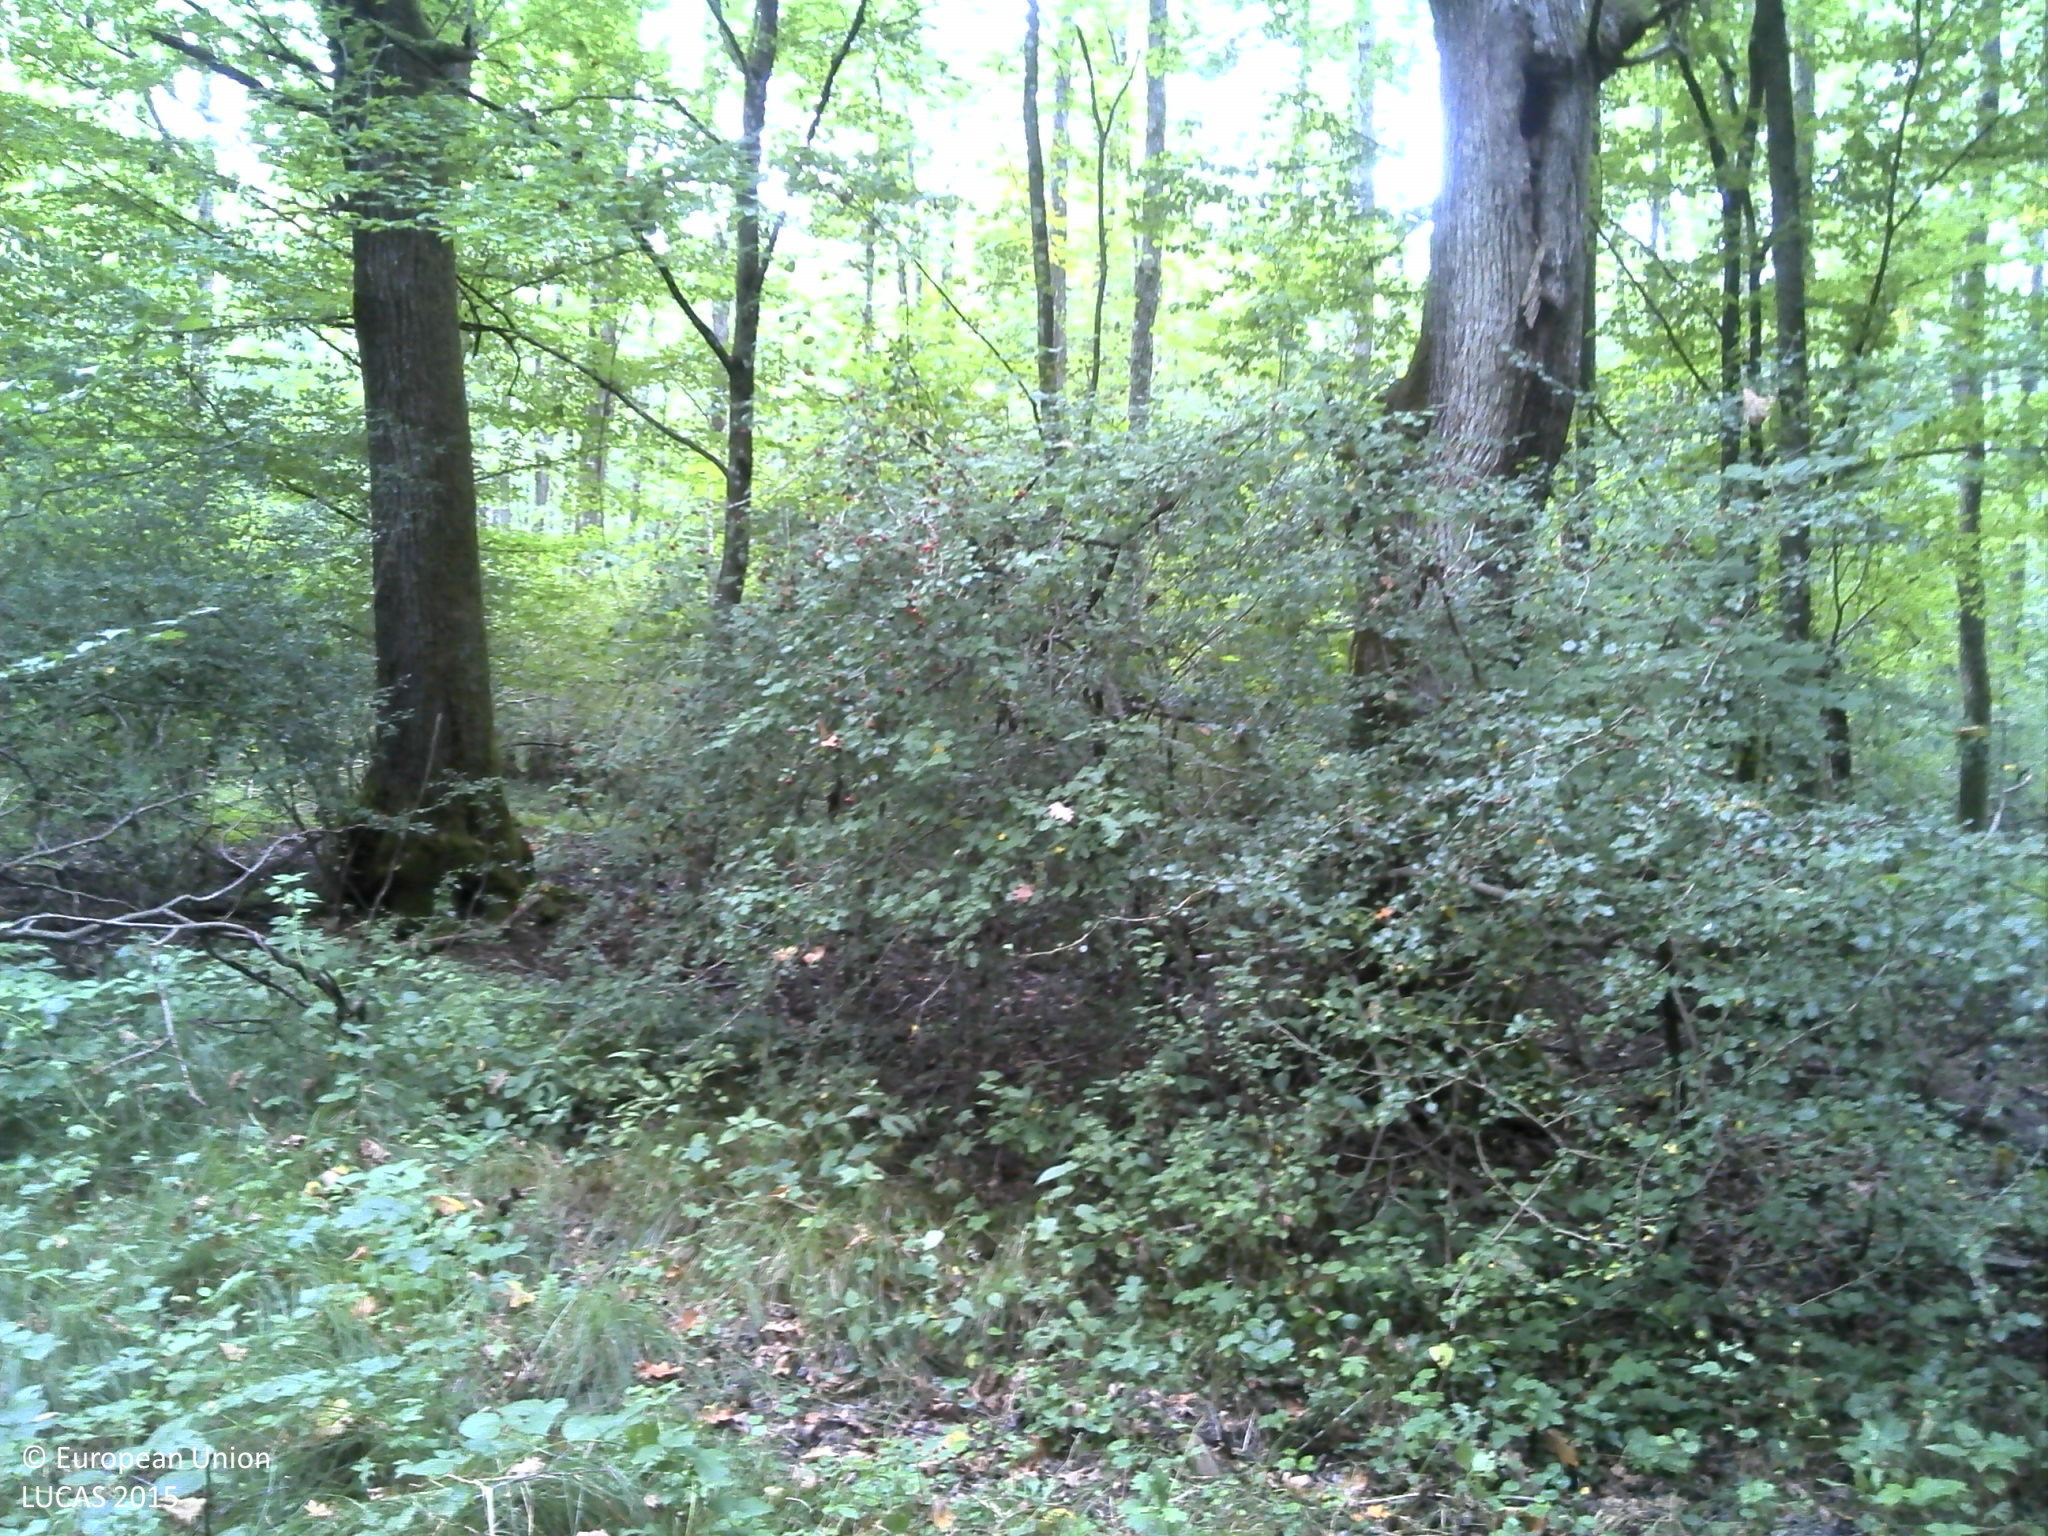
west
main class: Woodland
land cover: Broadleaved woodland
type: beech forest
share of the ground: > 75 %
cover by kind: broadleaved forest trees 100 %
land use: Forestry
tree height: > 5 m
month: August
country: HR
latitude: 45.4995
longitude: 15.6145
